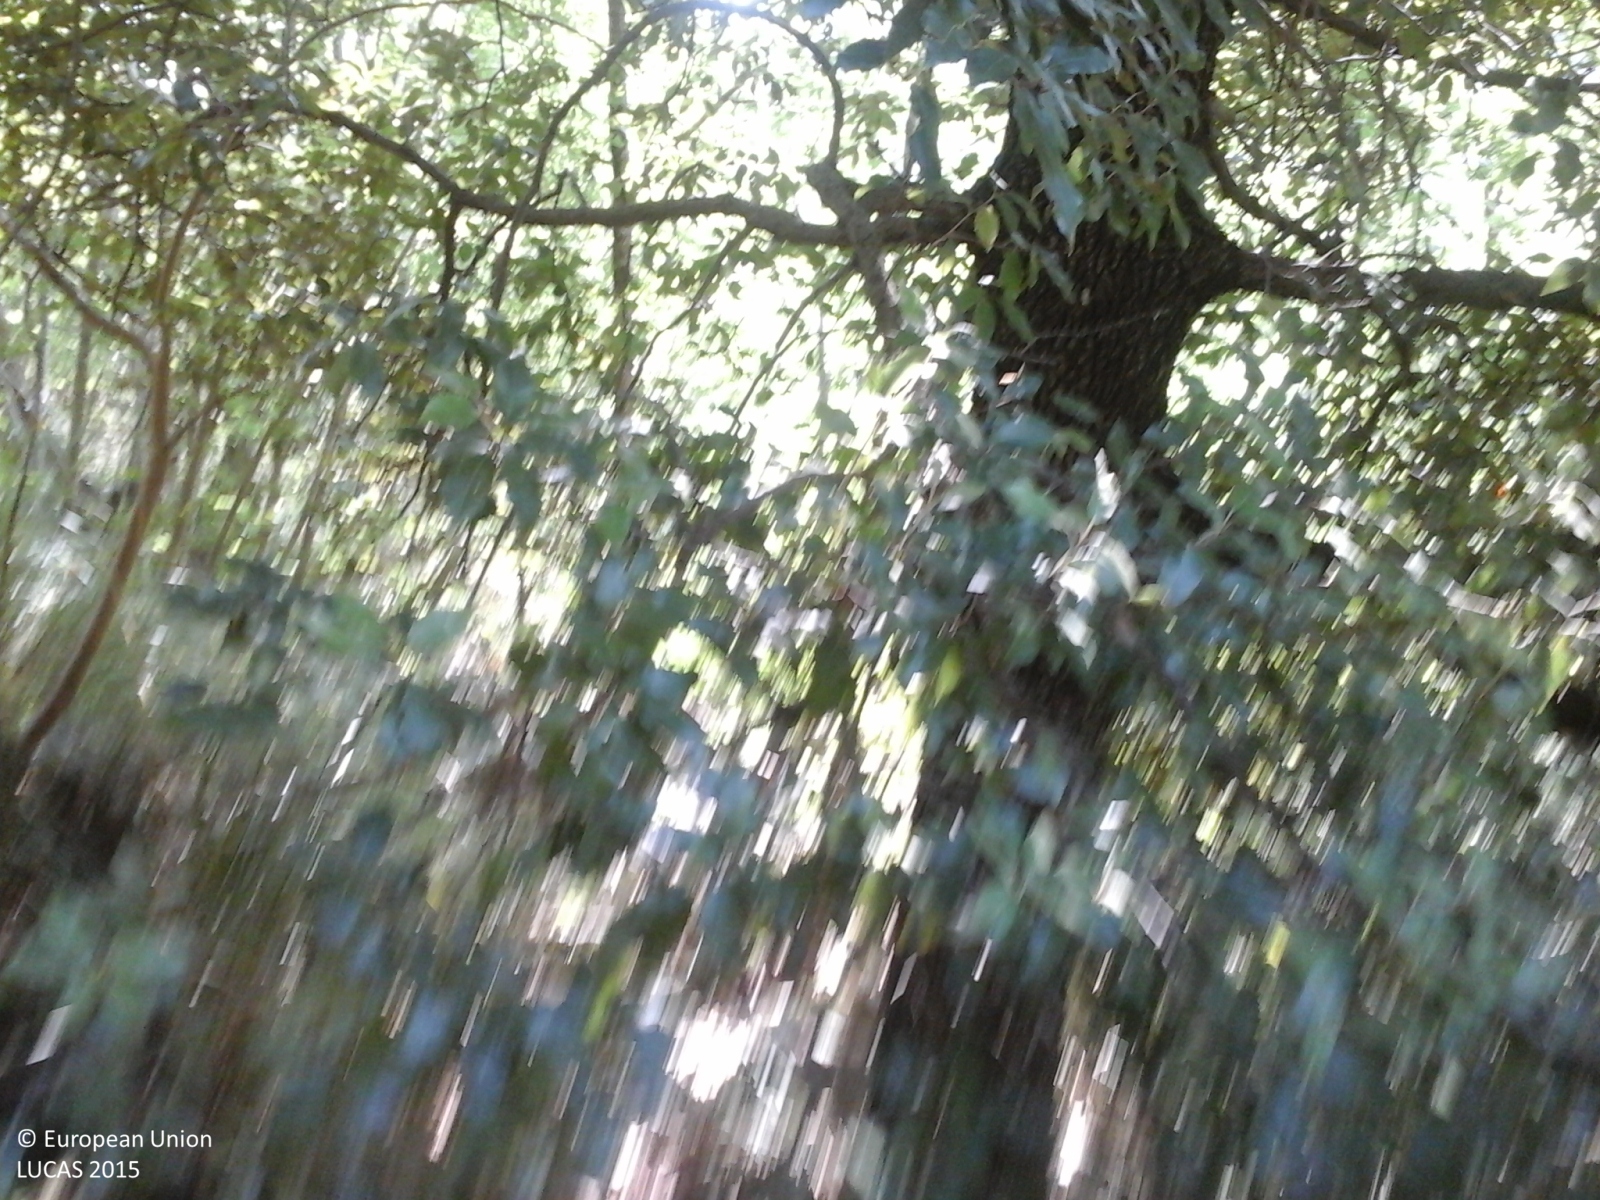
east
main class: Woodland
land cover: Broadleaved woodland
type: thermophilous deciduous forest
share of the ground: > 75 %
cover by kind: broadleaved forest trees 45 %, shrubs 30 %, herbaceous plants 25 %
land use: Semi-natural and natural areas not in use
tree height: < 5 m
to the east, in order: Broadleaved woodland; Rocks and stones; Broadleaved woodland; Paved roads, cycling and walking lanes; Grass margins; Other mixed woodland; Inland fresh running water; Broadleaved woodland; Grassland without tree/shrub cover
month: July
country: IT
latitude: 42.9311
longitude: 11.5513
